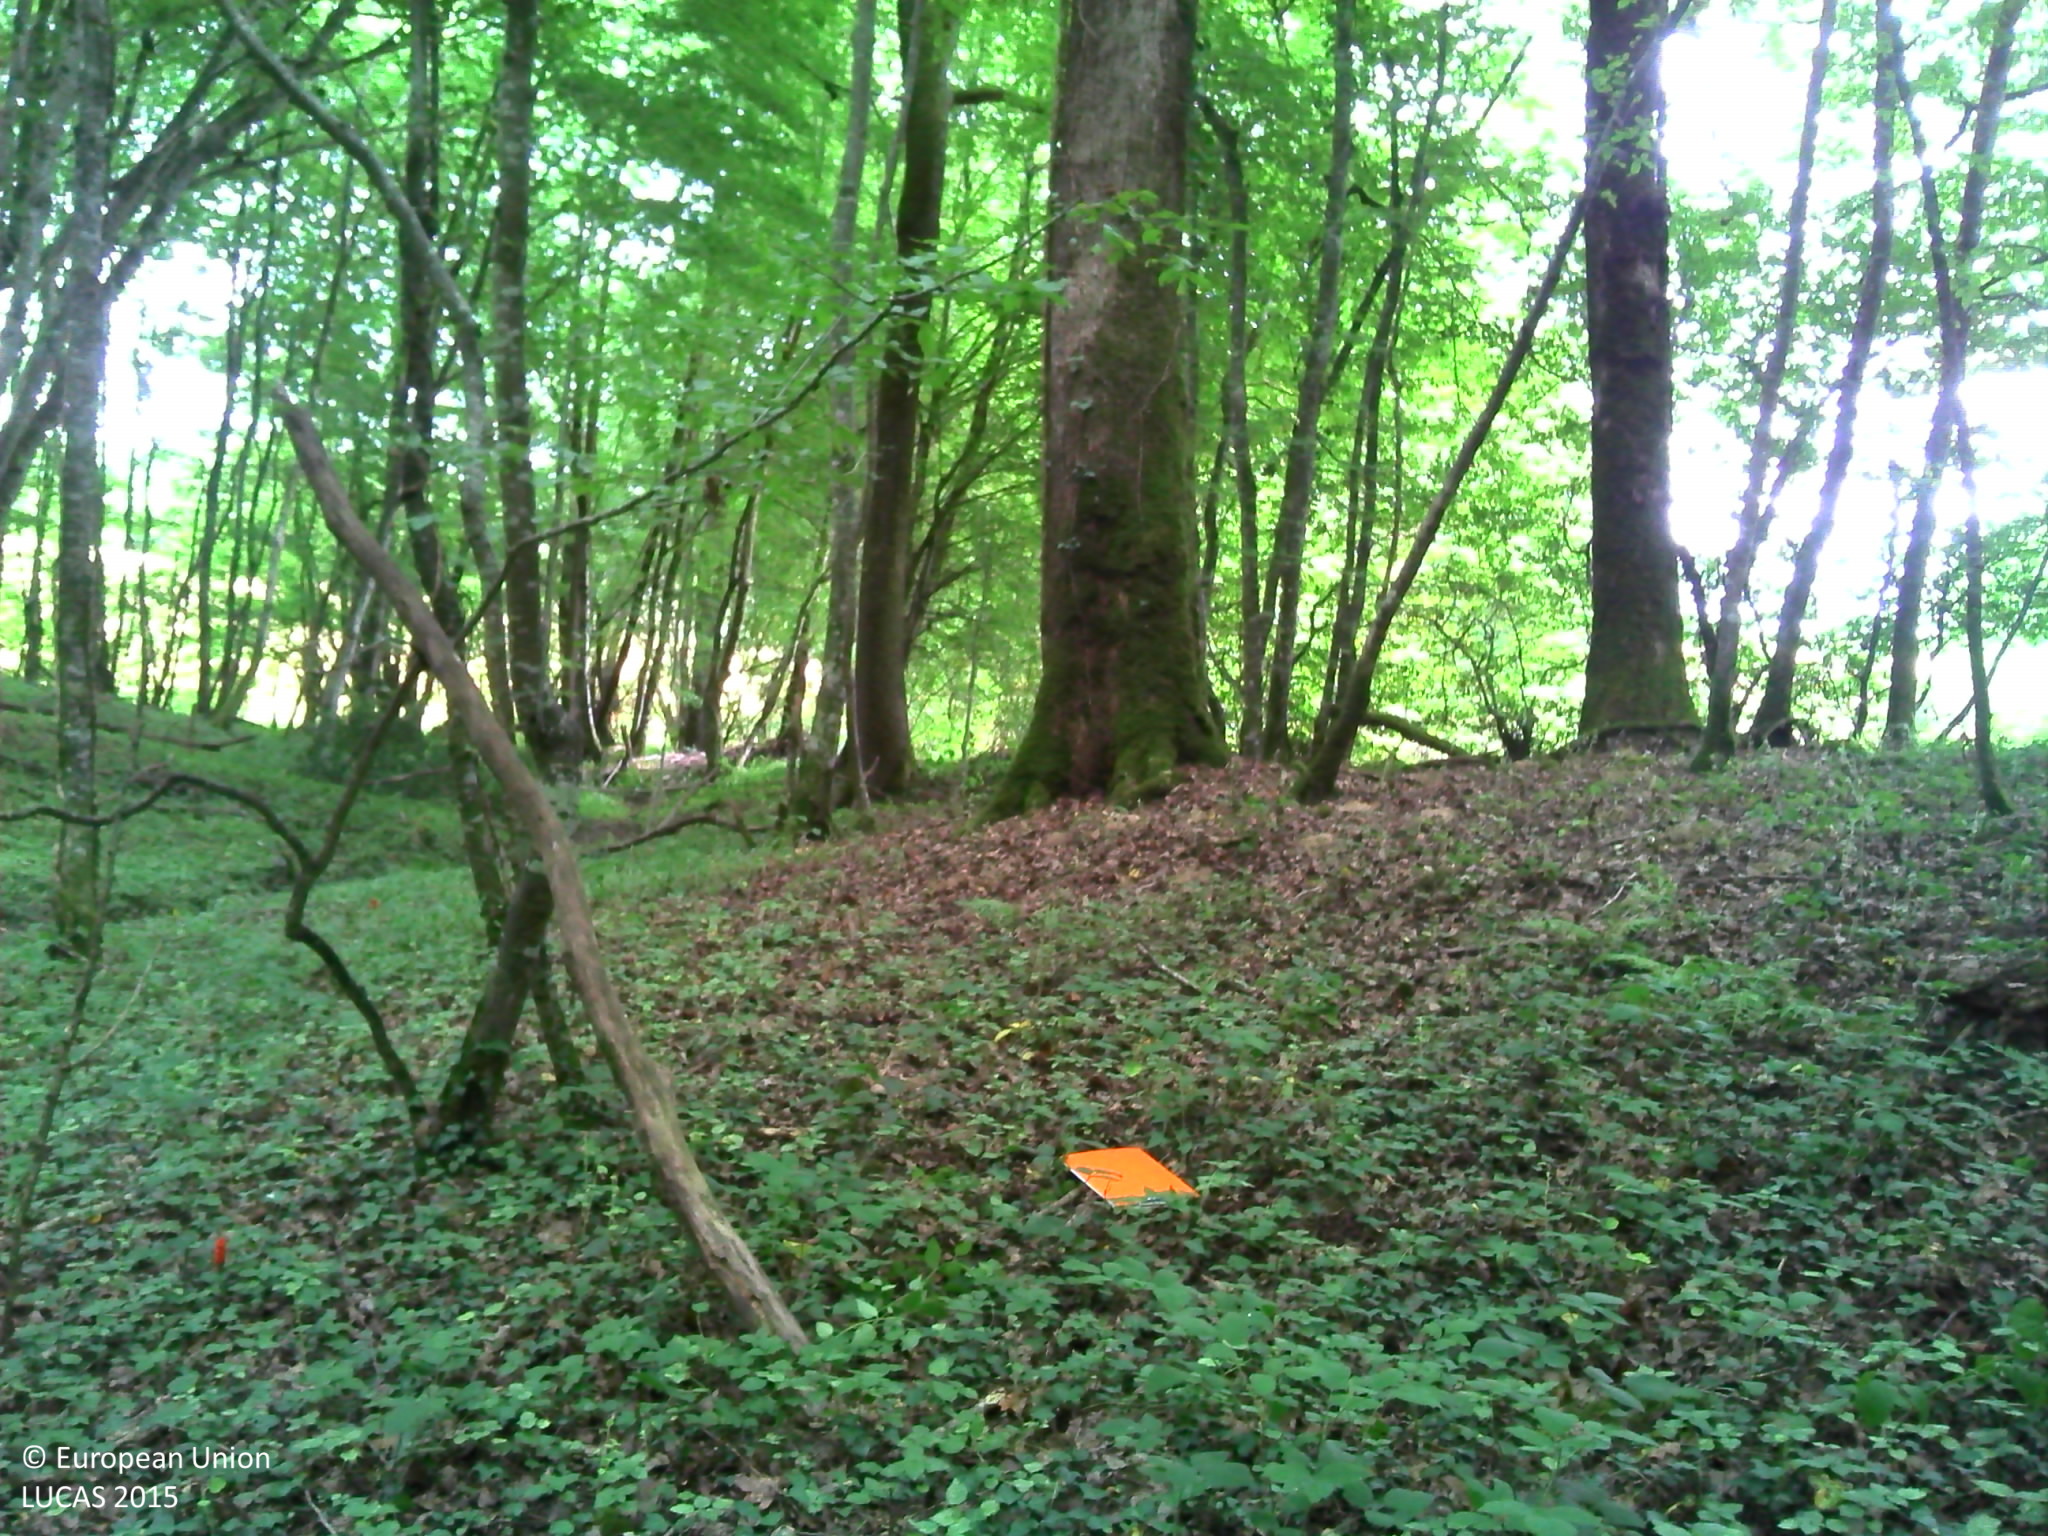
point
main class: Woodland
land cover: Broadleaved woodland
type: mesophytic deciduous forest
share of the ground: > 75 %
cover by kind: broadleaved forest trees 95 %, herbaceous plants 5 %
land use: Forestry
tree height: > 5 m
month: July
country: FR
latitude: 46.5413
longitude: 2.7850
